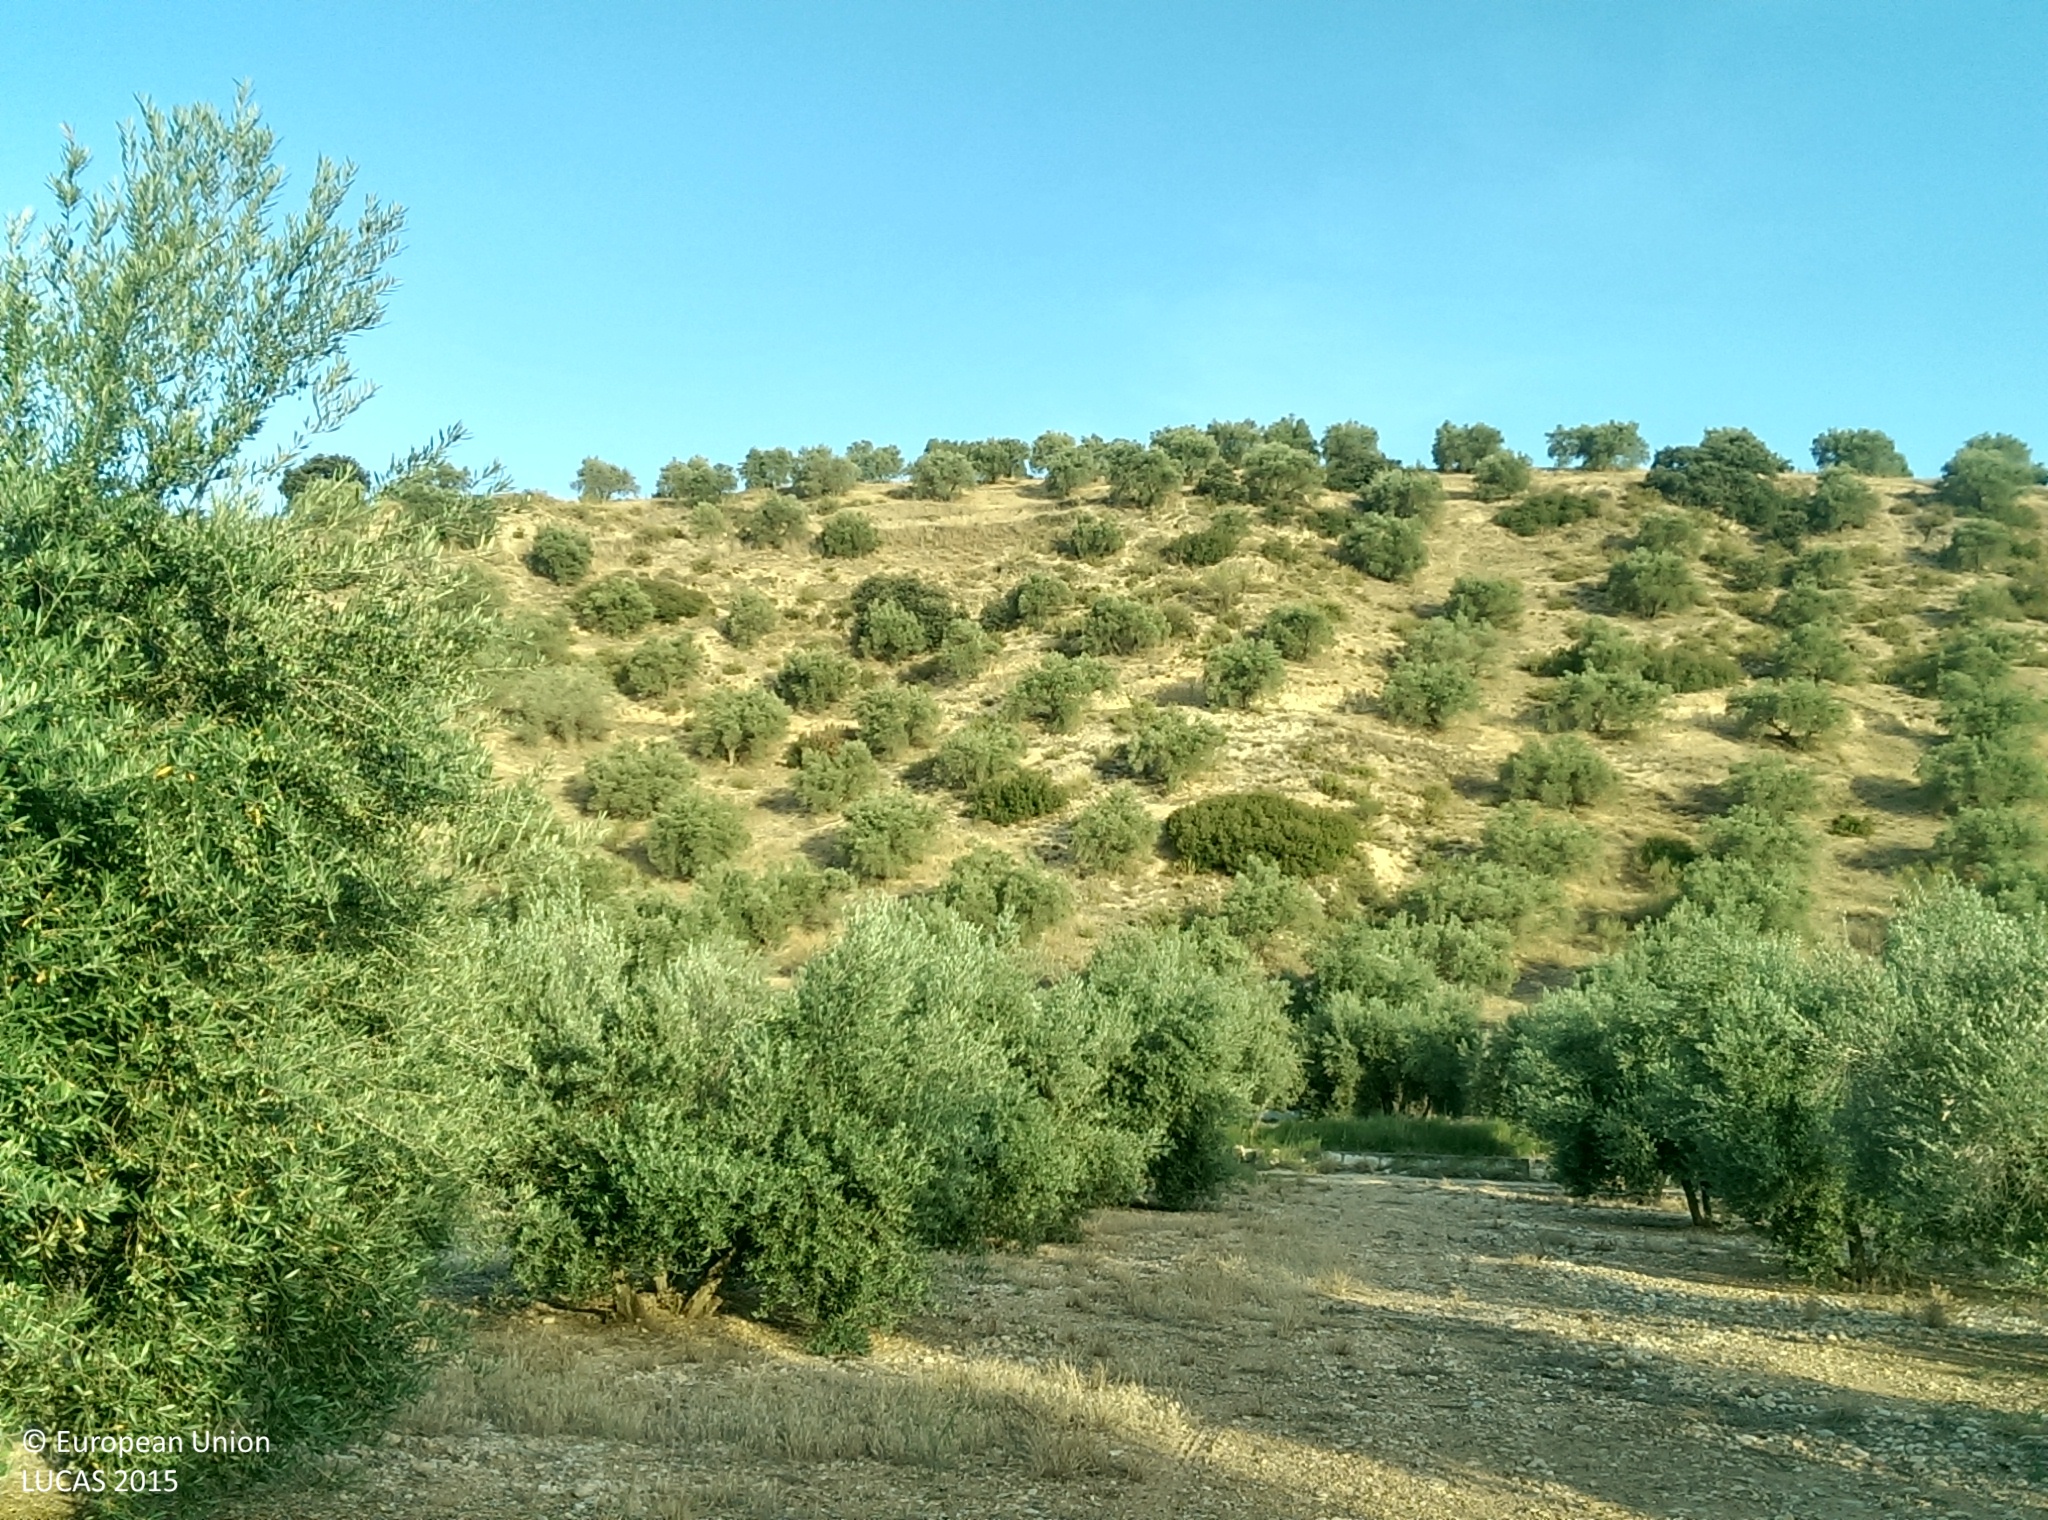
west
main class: Cropland
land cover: Olive groves
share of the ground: 50 - 75 %
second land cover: Other bare soil
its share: > 75 %
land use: Agriculture (excluding fallow land and kitchen gardens)
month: July
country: ES
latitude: 37.3198
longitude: -3.7032
